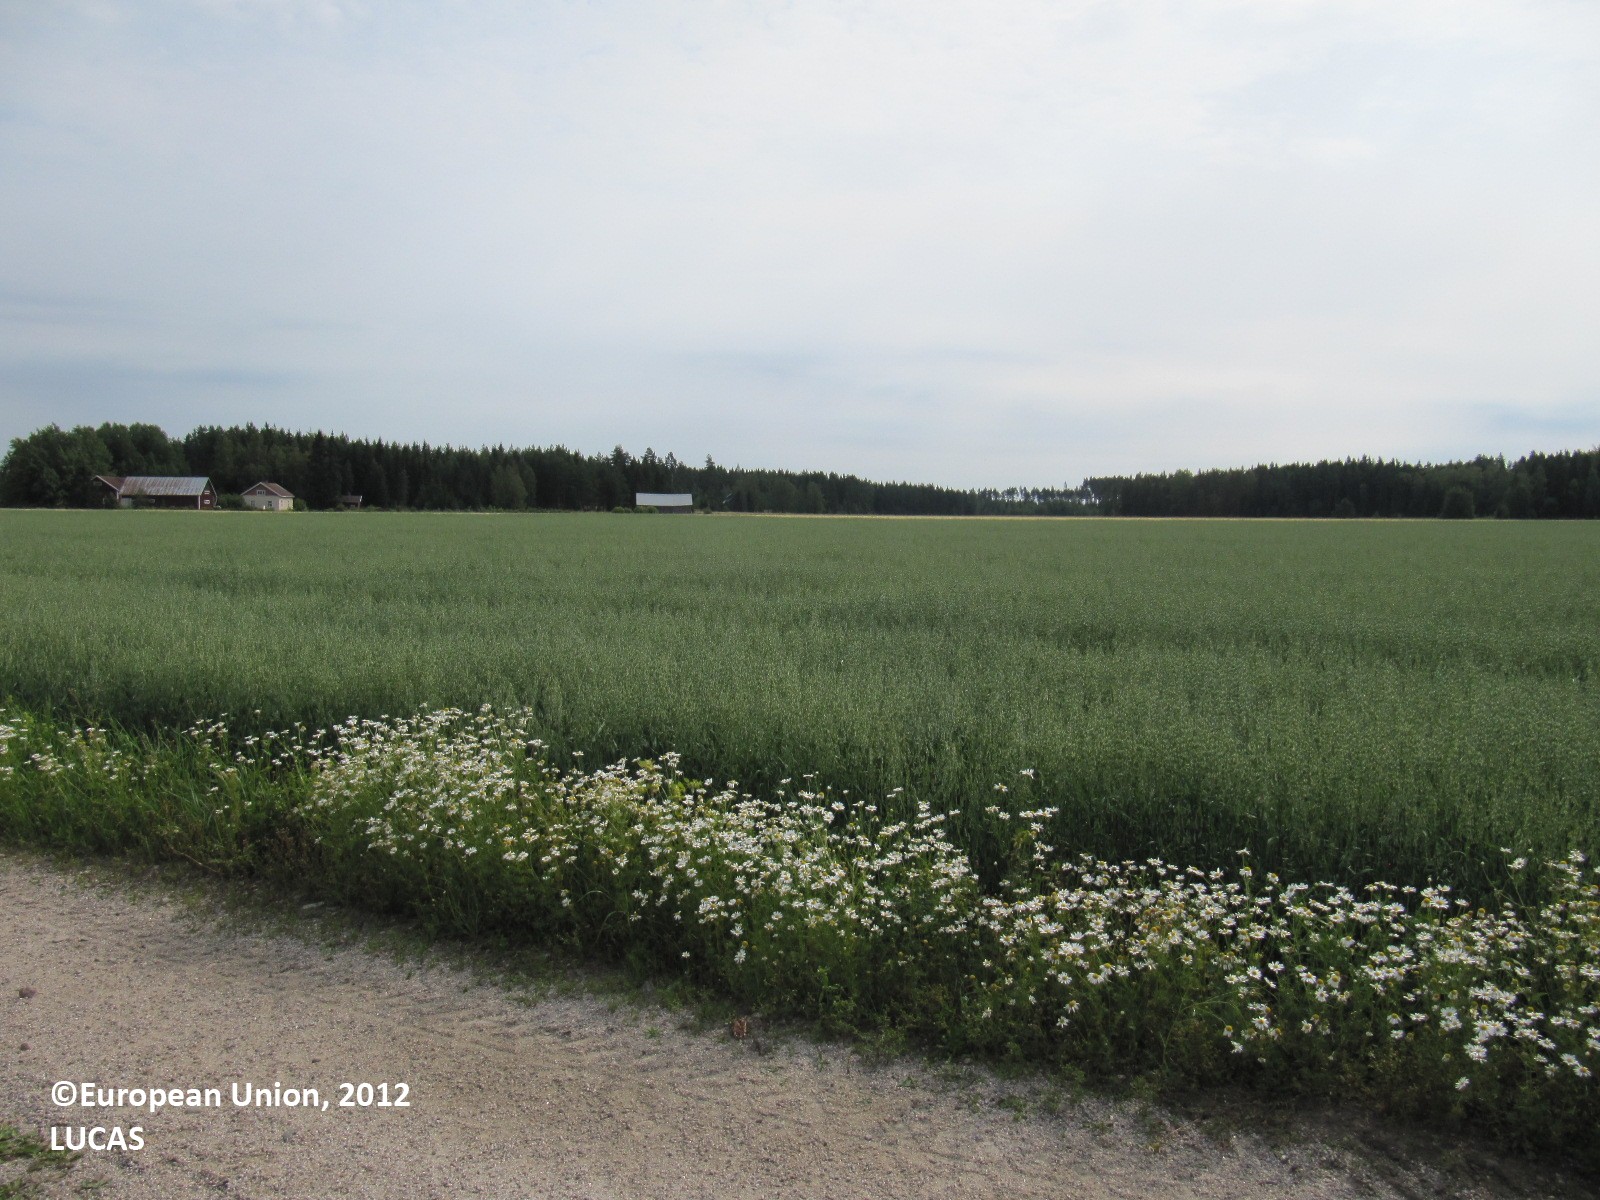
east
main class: Cropland
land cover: Oats
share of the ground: > 75 %
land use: Agriculture (excluding fallow land and kitchen gardens)
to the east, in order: Oats; Grass margins; Tracks; Grass margins; Oats; Ditches and canals; Barley
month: August
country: FI
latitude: 60.4826
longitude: 23.2748
